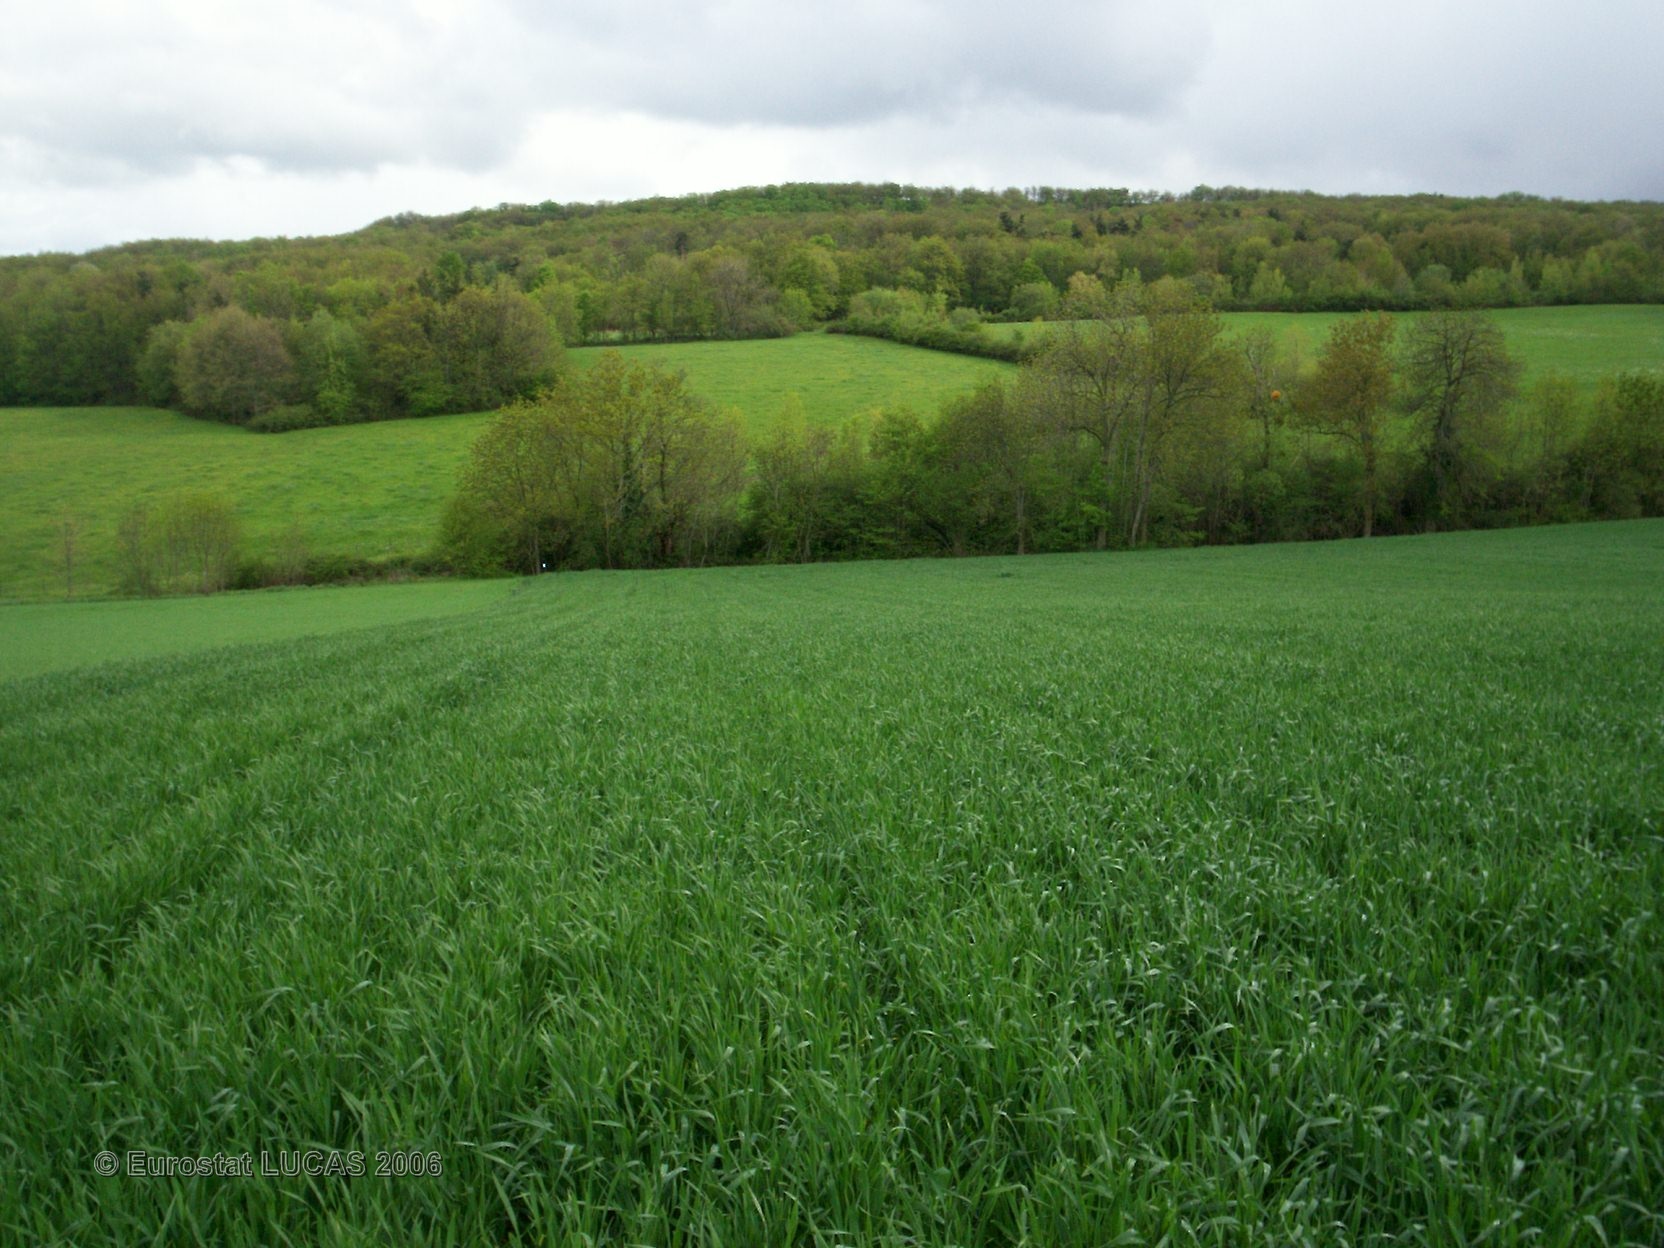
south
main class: Cropland
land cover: Common wheat
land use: Agriculture (excluding fallow land and kitchen gardens)
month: May
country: FR
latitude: 45.4974
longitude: 3.1287
